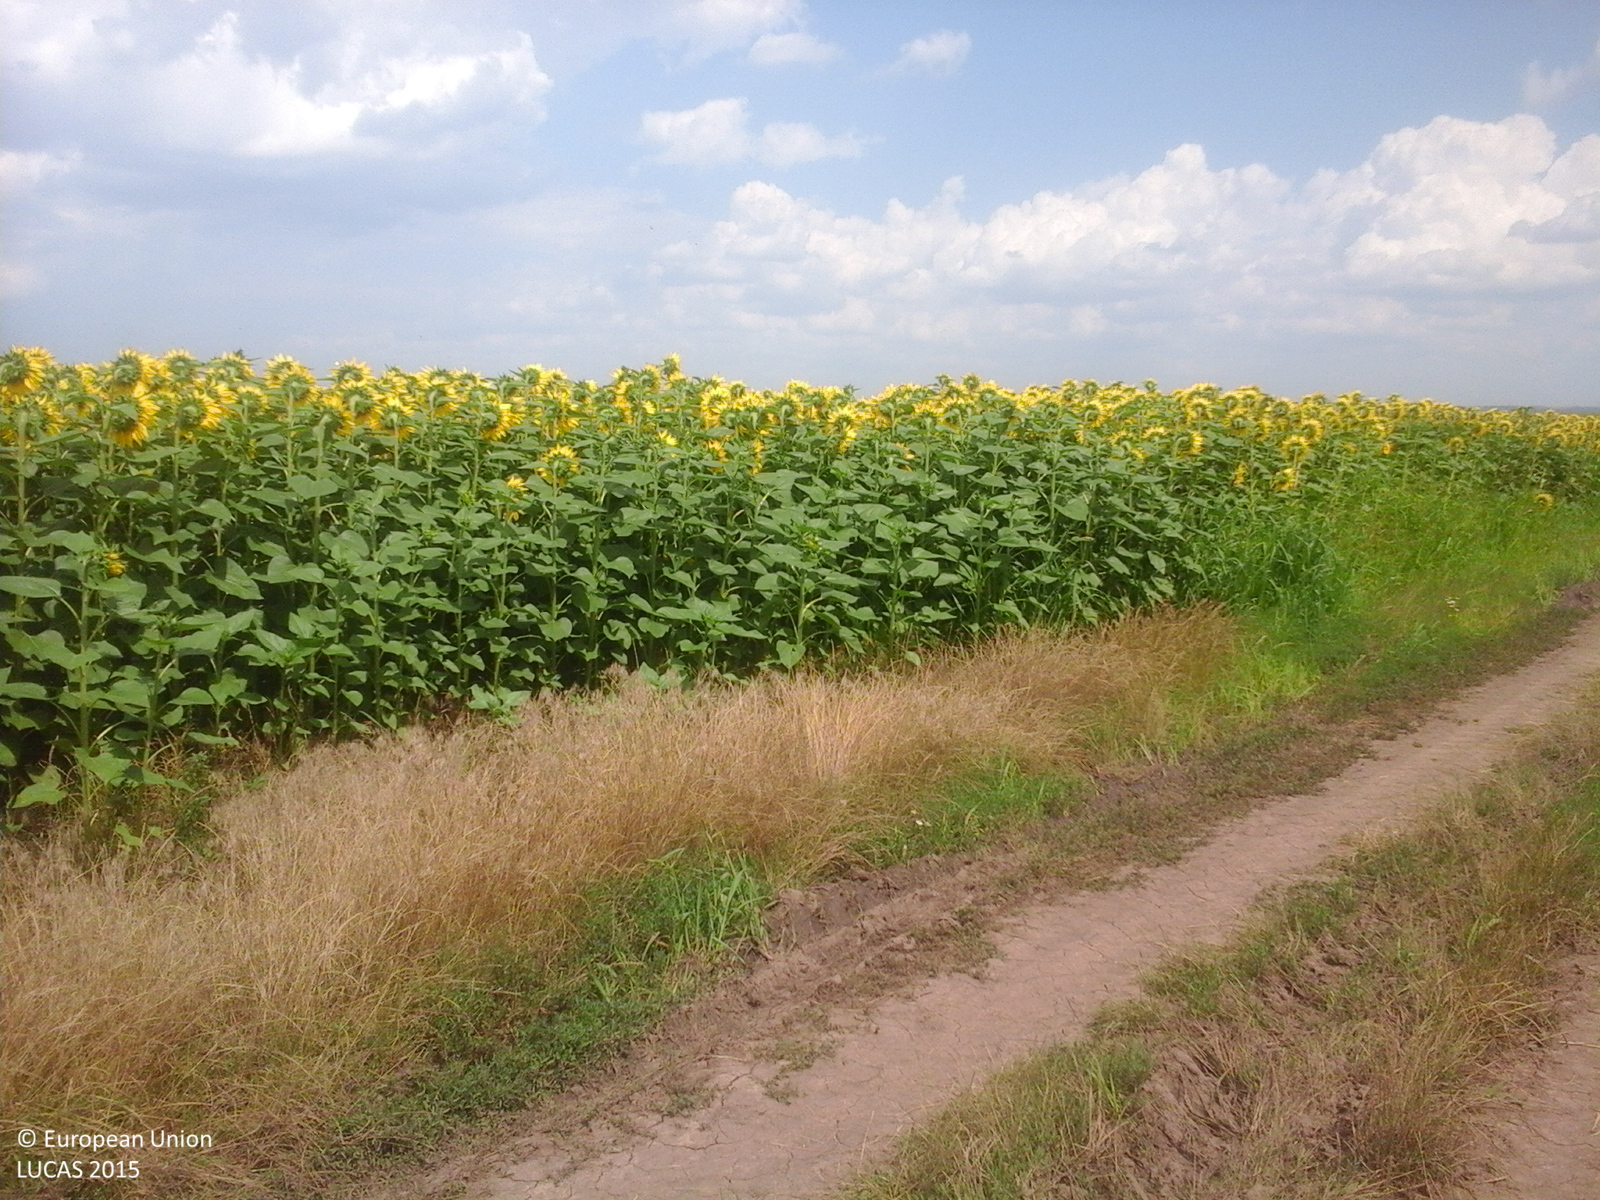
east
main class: Cropland
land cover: Common wheat
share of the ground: > 75 %
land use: Agriculture (excluding fallow land and kitchen gardens)
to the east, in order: Common wheat; Shrubland with sparse tree cover; Tracks; Maize; Tracks; Maize
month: July
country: RO
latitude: 43.8186
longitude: 25.7435
